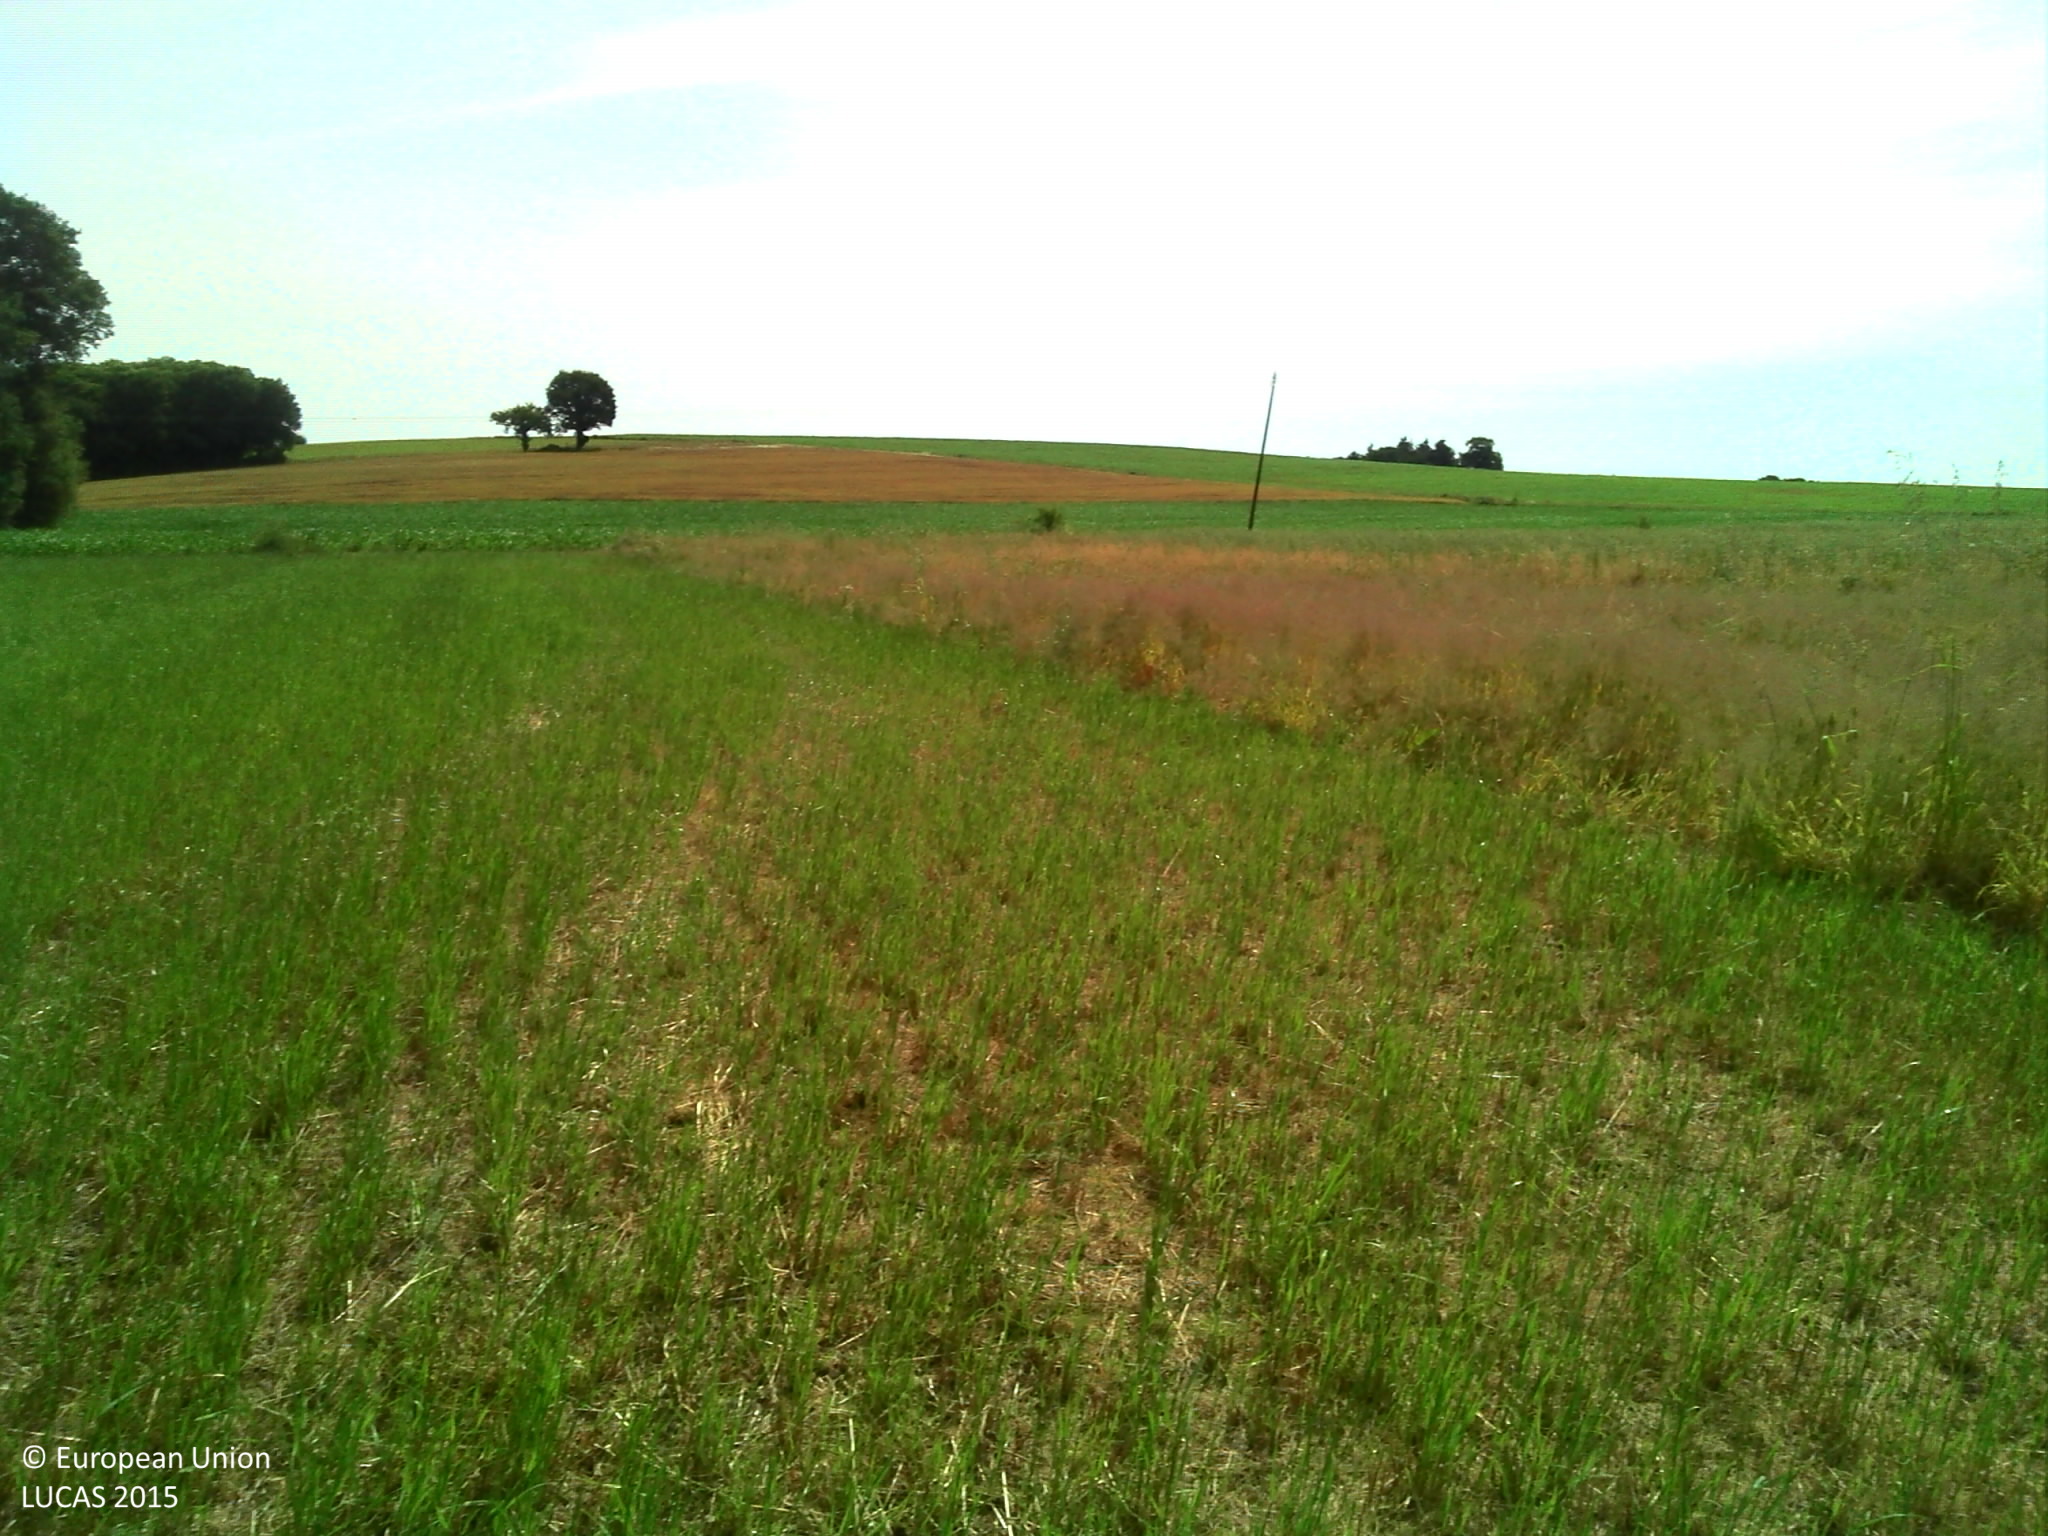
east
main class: Grassland
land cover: Grassland without tree/shrub cover
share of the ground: > 75 %
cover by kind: herbaceous plants 100 %
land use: Agriculture (excluding fallow land and kitchen gardens)
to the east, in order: Grassland without tree/shrub cover; Ditches and canals; Maize; Electric lines; Maize; Other fibre and oleaginous crops
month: June
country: FR
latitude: 48.0792
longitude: -1.9581
